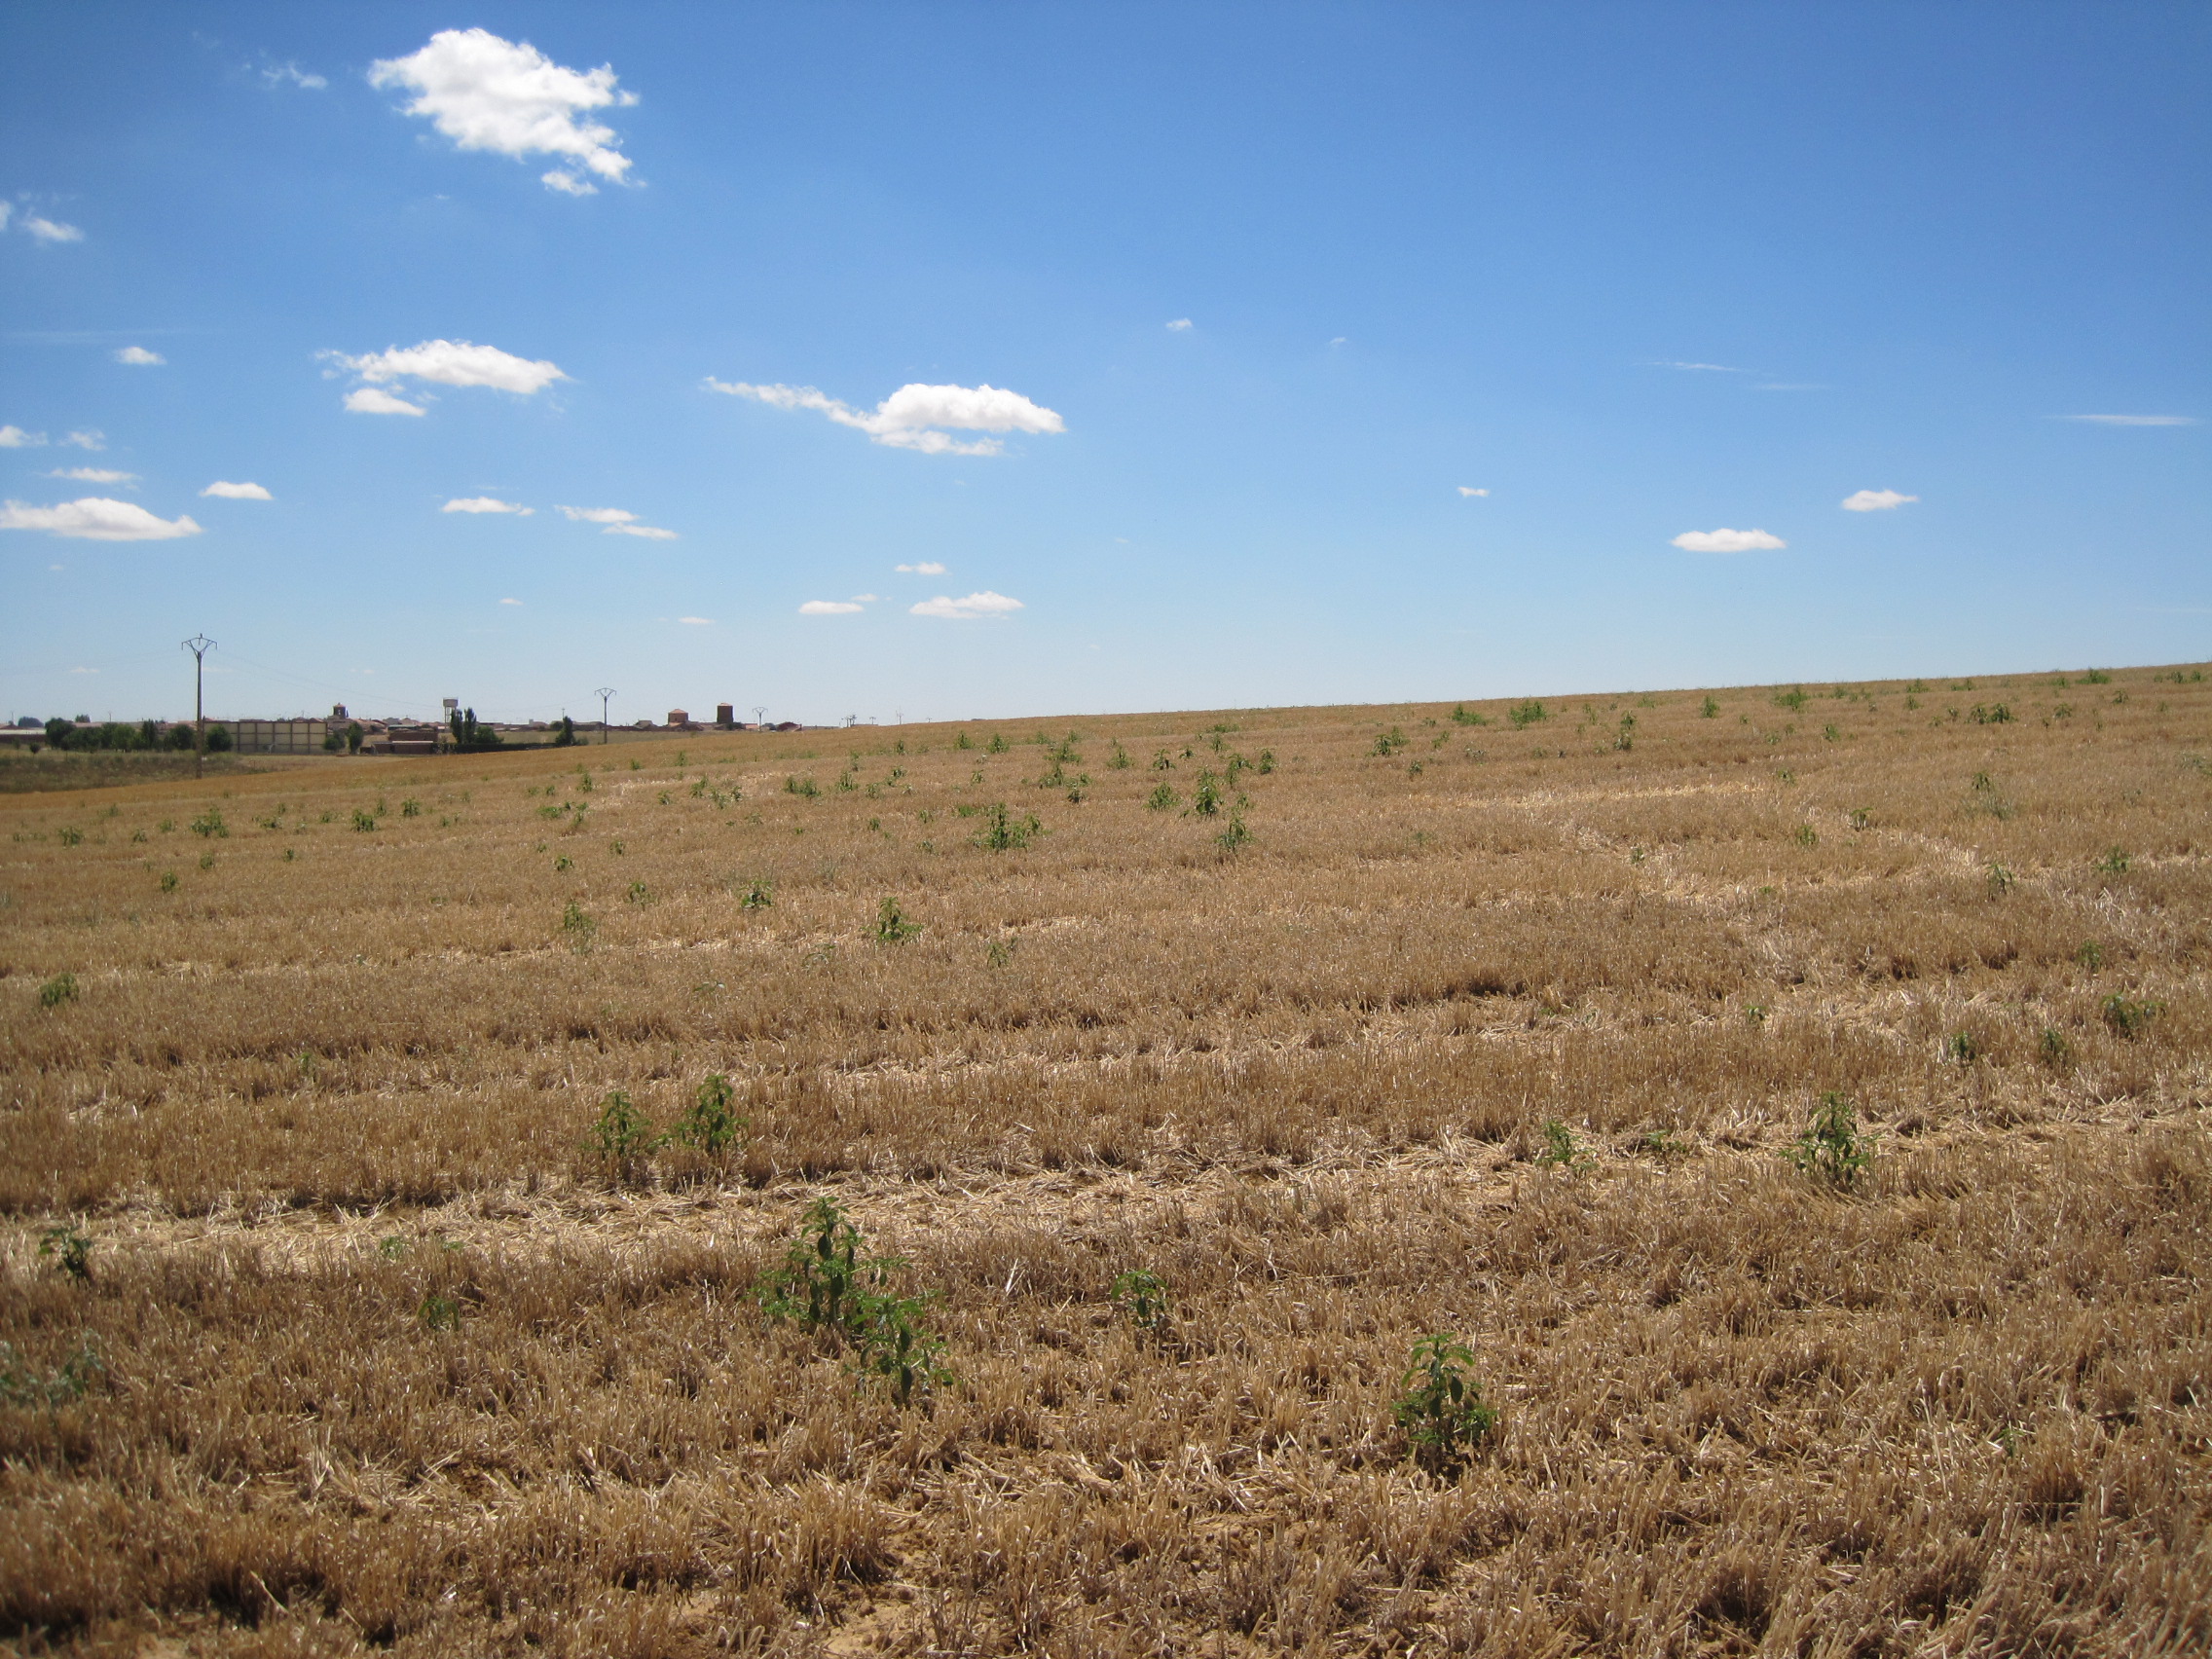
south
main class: Cropland
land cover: Barley
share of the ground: < 10 %
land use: Agriculture (excluding fallow land and kitchen gardens)
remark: Harvested field
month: July
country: ES
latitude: 42.0125
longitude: -5.5577
